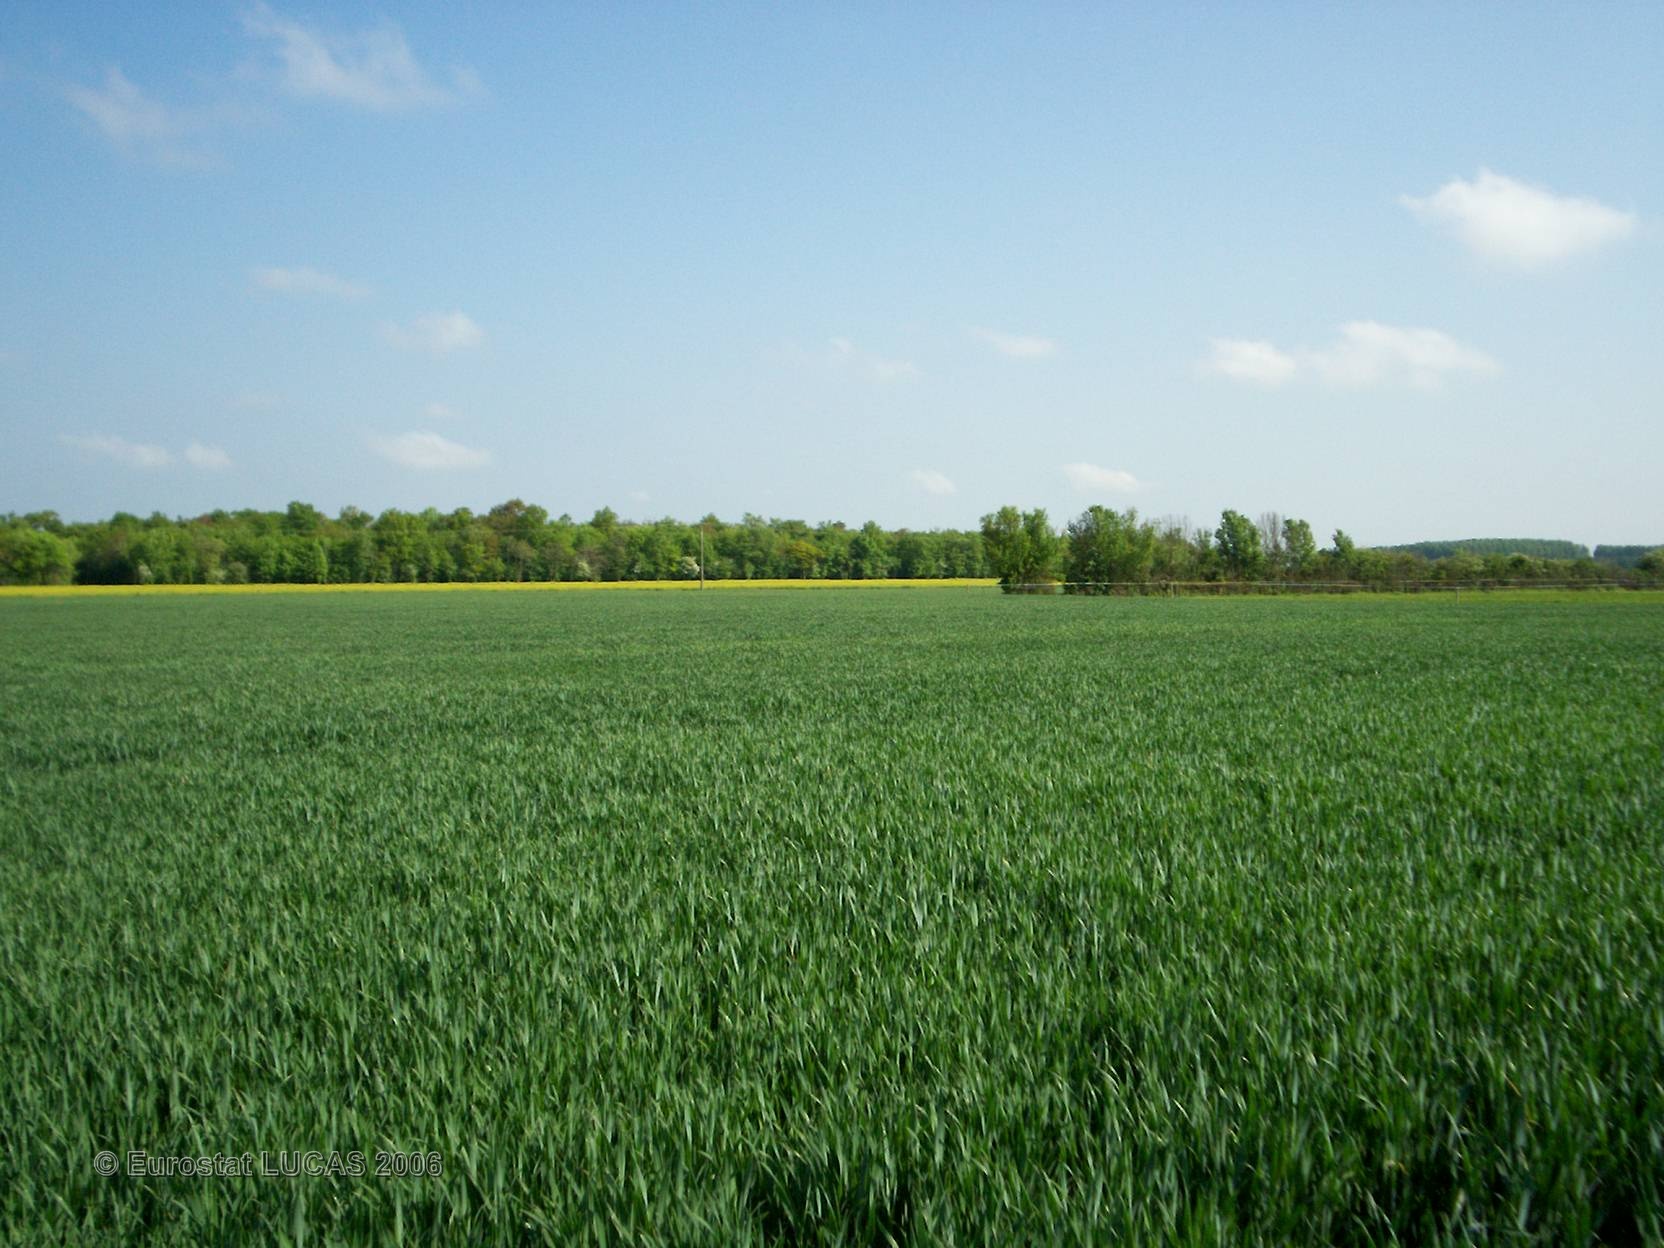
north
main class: Cropland
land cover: Common wheat
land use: Agriculture (excluding fallow land and kitchen gardens)
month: May
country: FR
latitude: 47.4109
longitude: 0.2625
